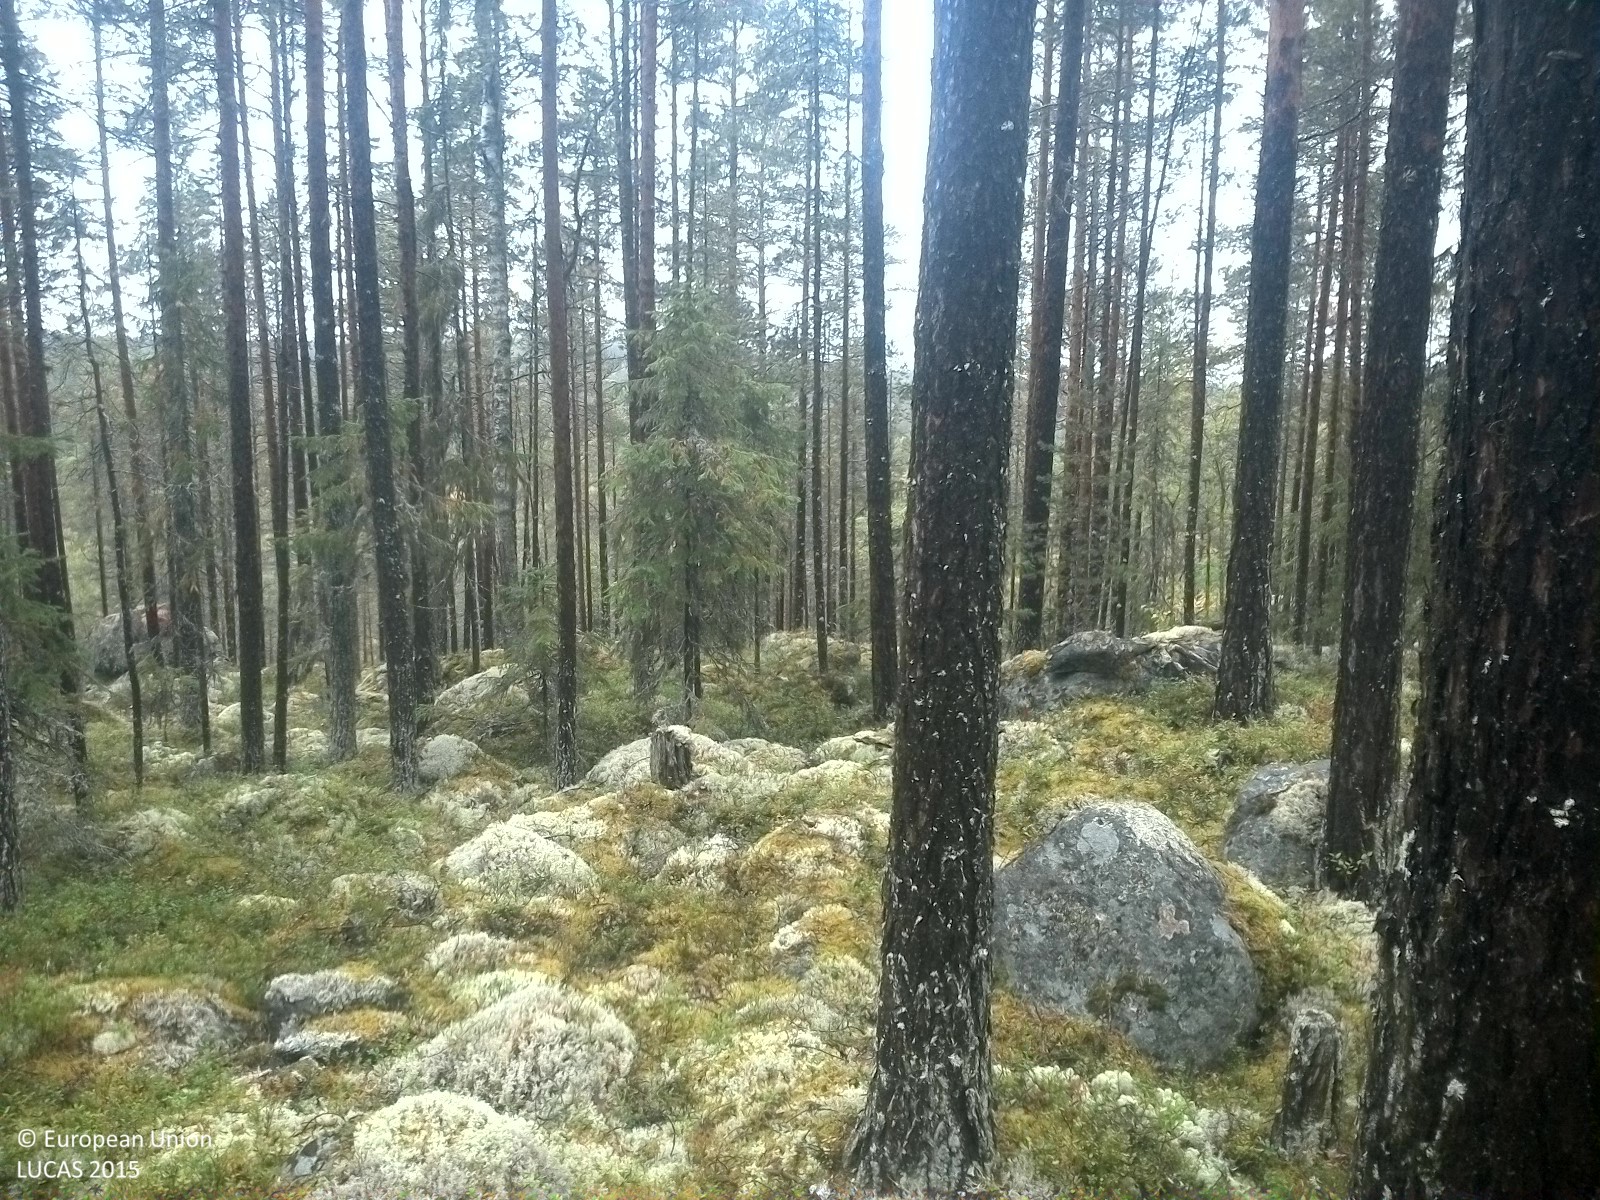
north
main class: Woodland
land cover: Pine dominated coniferous woodland
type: boreal forest
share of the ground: 25 - 50 %
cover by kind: coniferous forest trees 40 %, lichens and mosses 40 %, shrubs 20 %
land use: Forestry
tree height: > 5 m
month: September
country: SE
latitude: 62.2155
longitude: 15.6920
